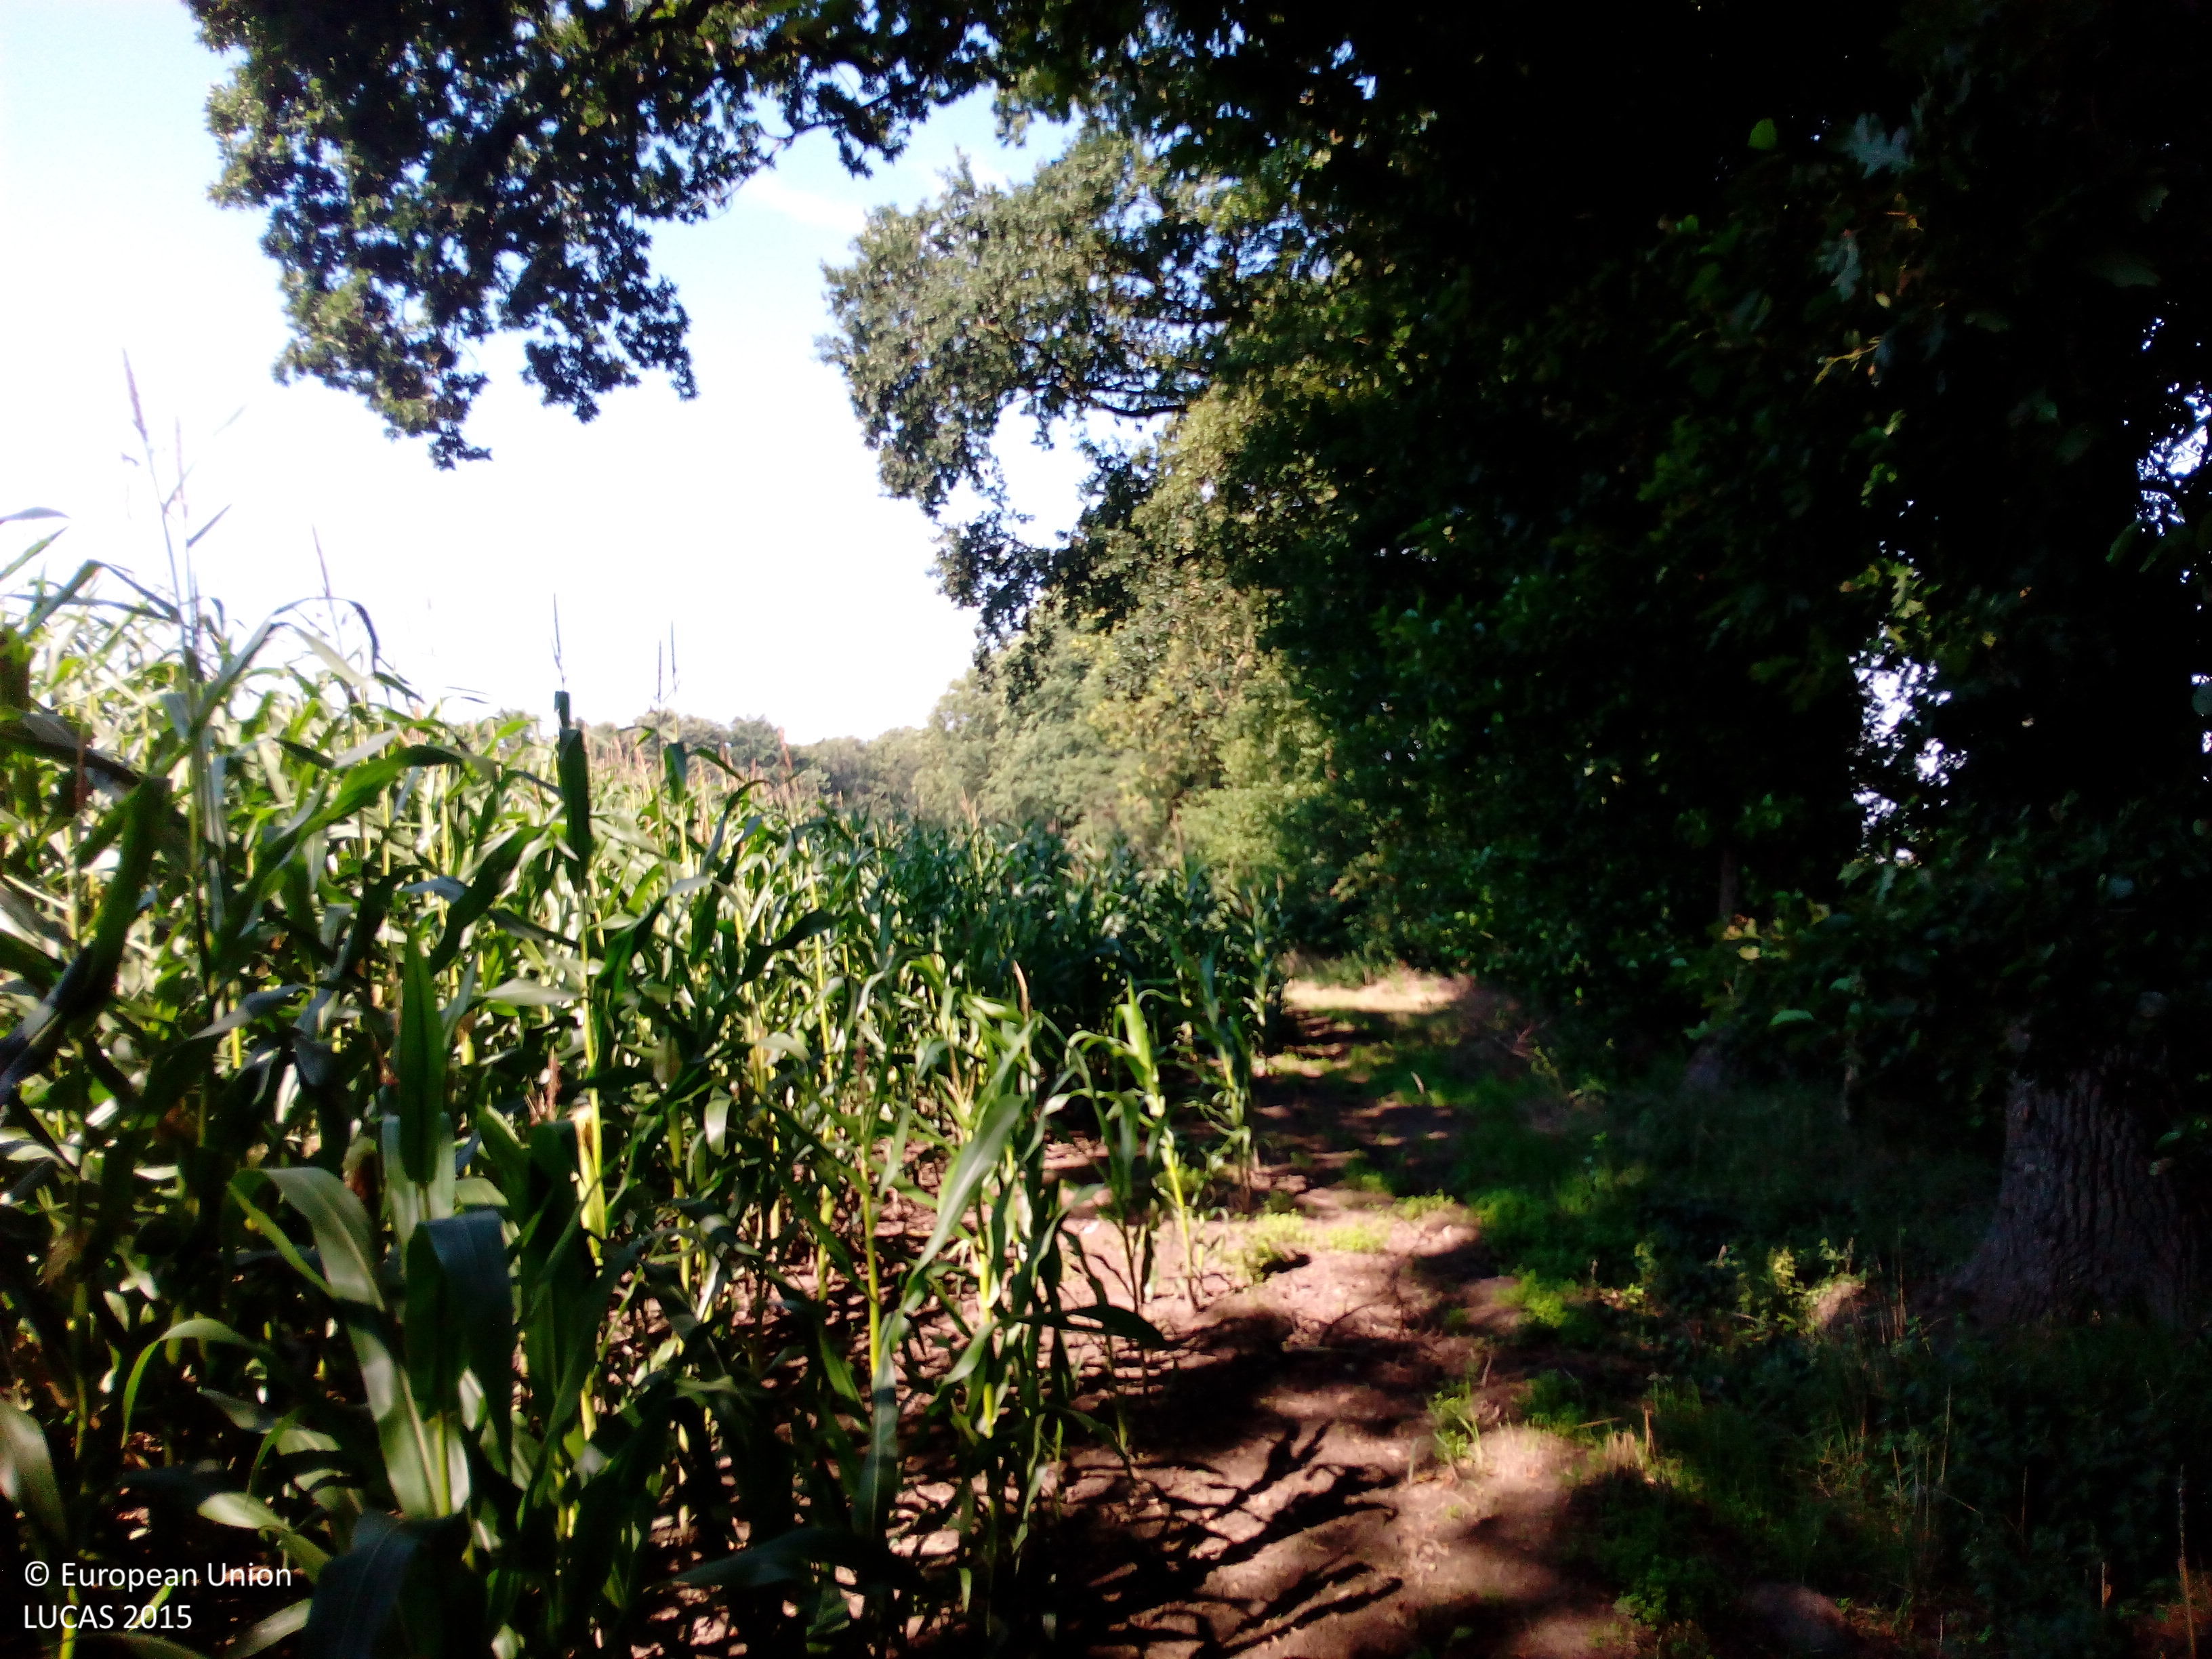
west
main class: Cropland
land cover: Maize
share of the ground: > 75 %
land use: Agriculture (excluding fallow land and kitchen gardens)
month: August
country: DE
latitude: 52.7023
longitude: 8.0027
